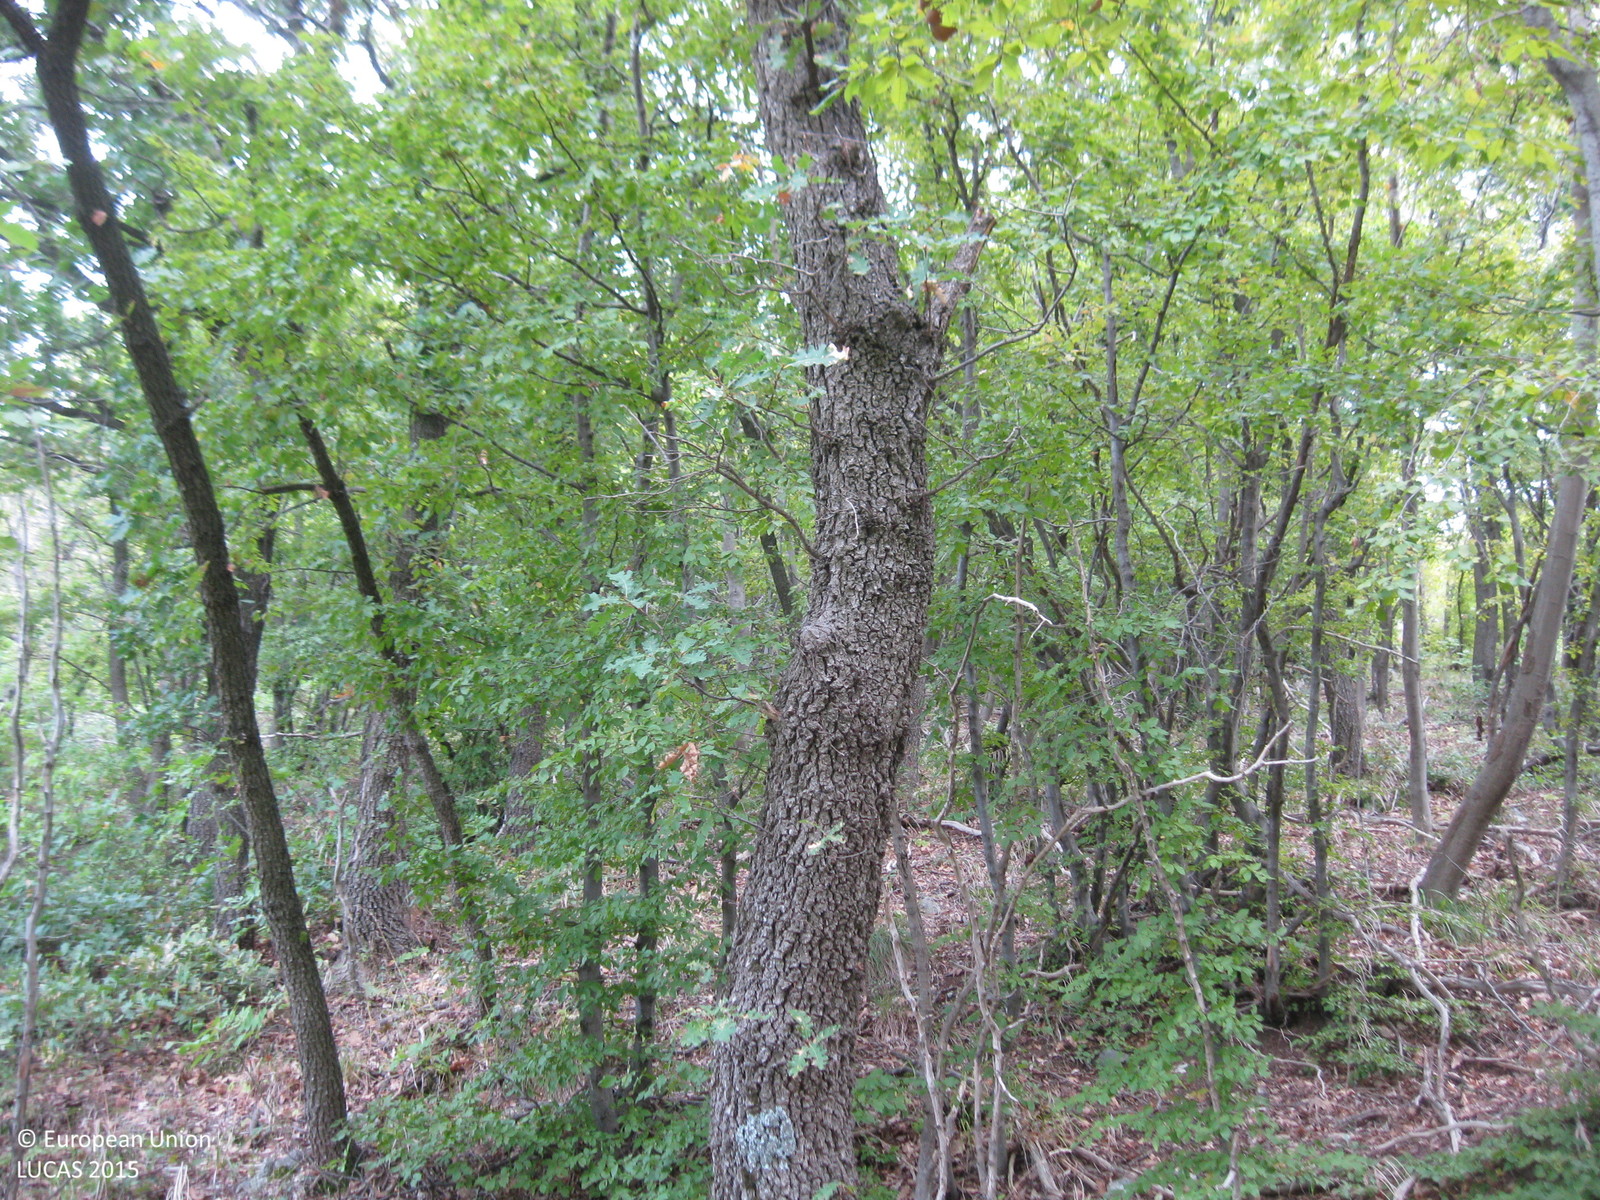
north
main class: Woodland
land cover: Broadleaved woodland
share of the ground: > 75 %
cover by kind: broadleaved forest trees 100 %
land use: Forestry
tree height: < 5 m
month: October
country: BG
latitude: 42.0505
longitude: 24.7054
